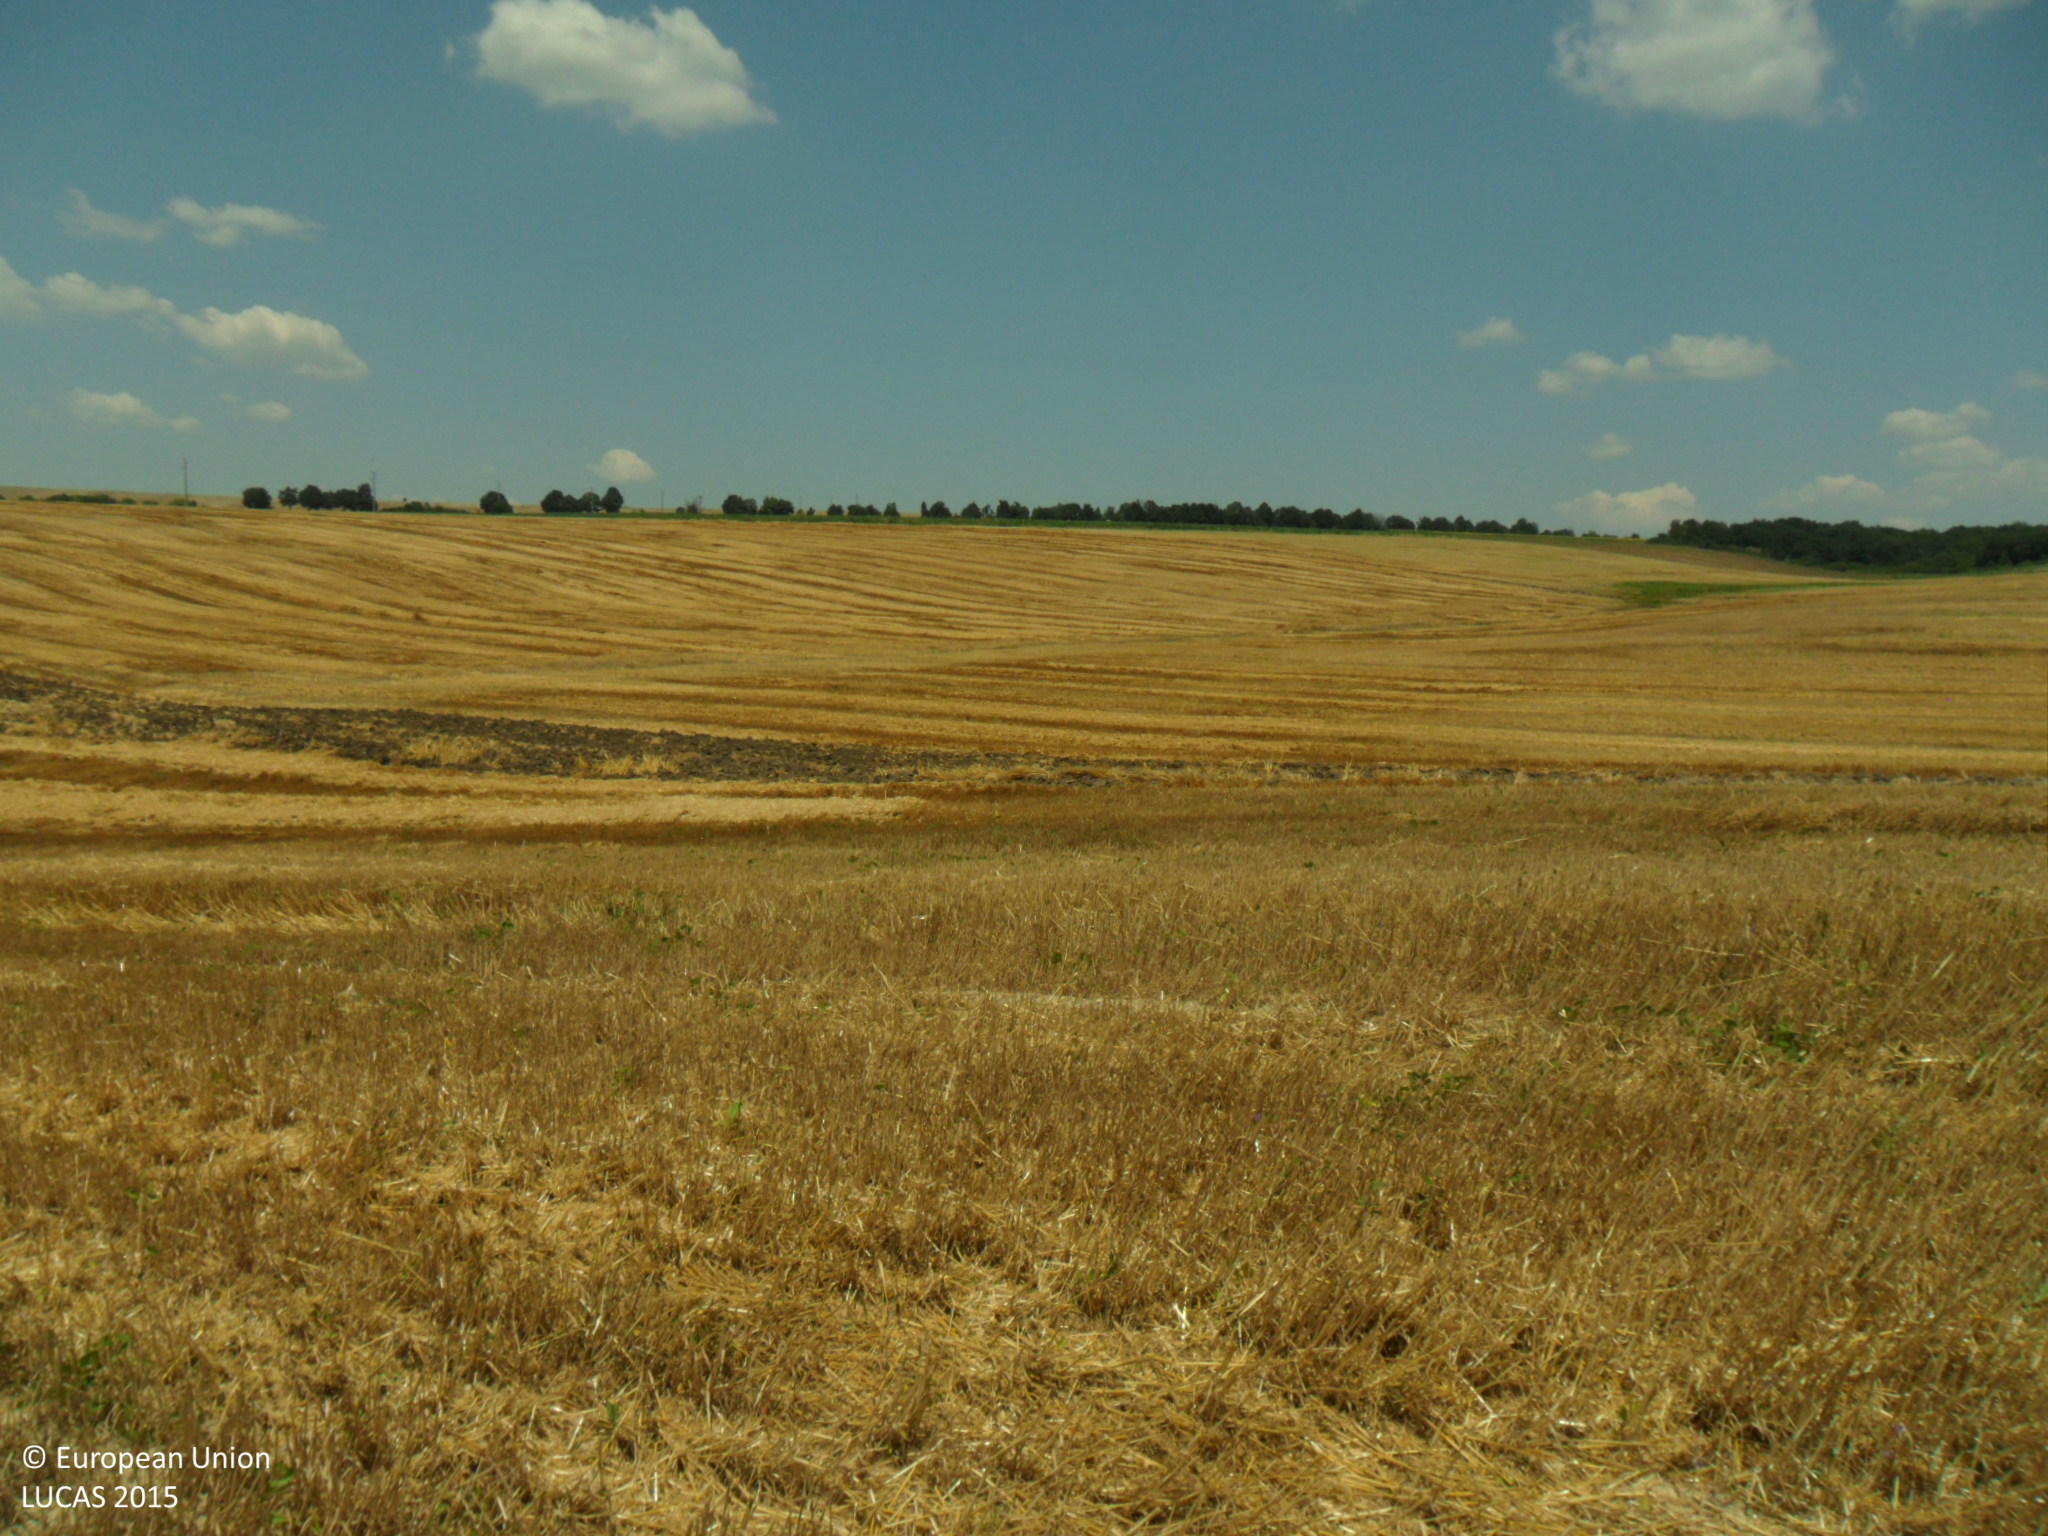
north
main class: Cropland
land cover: Common wheat
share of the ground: 10 - 25 %
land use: Agriculture (excluding fallow land and kitchen gardens)
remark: Harvested field
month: July
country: BG
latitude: 43.4216
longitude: 26.6207
